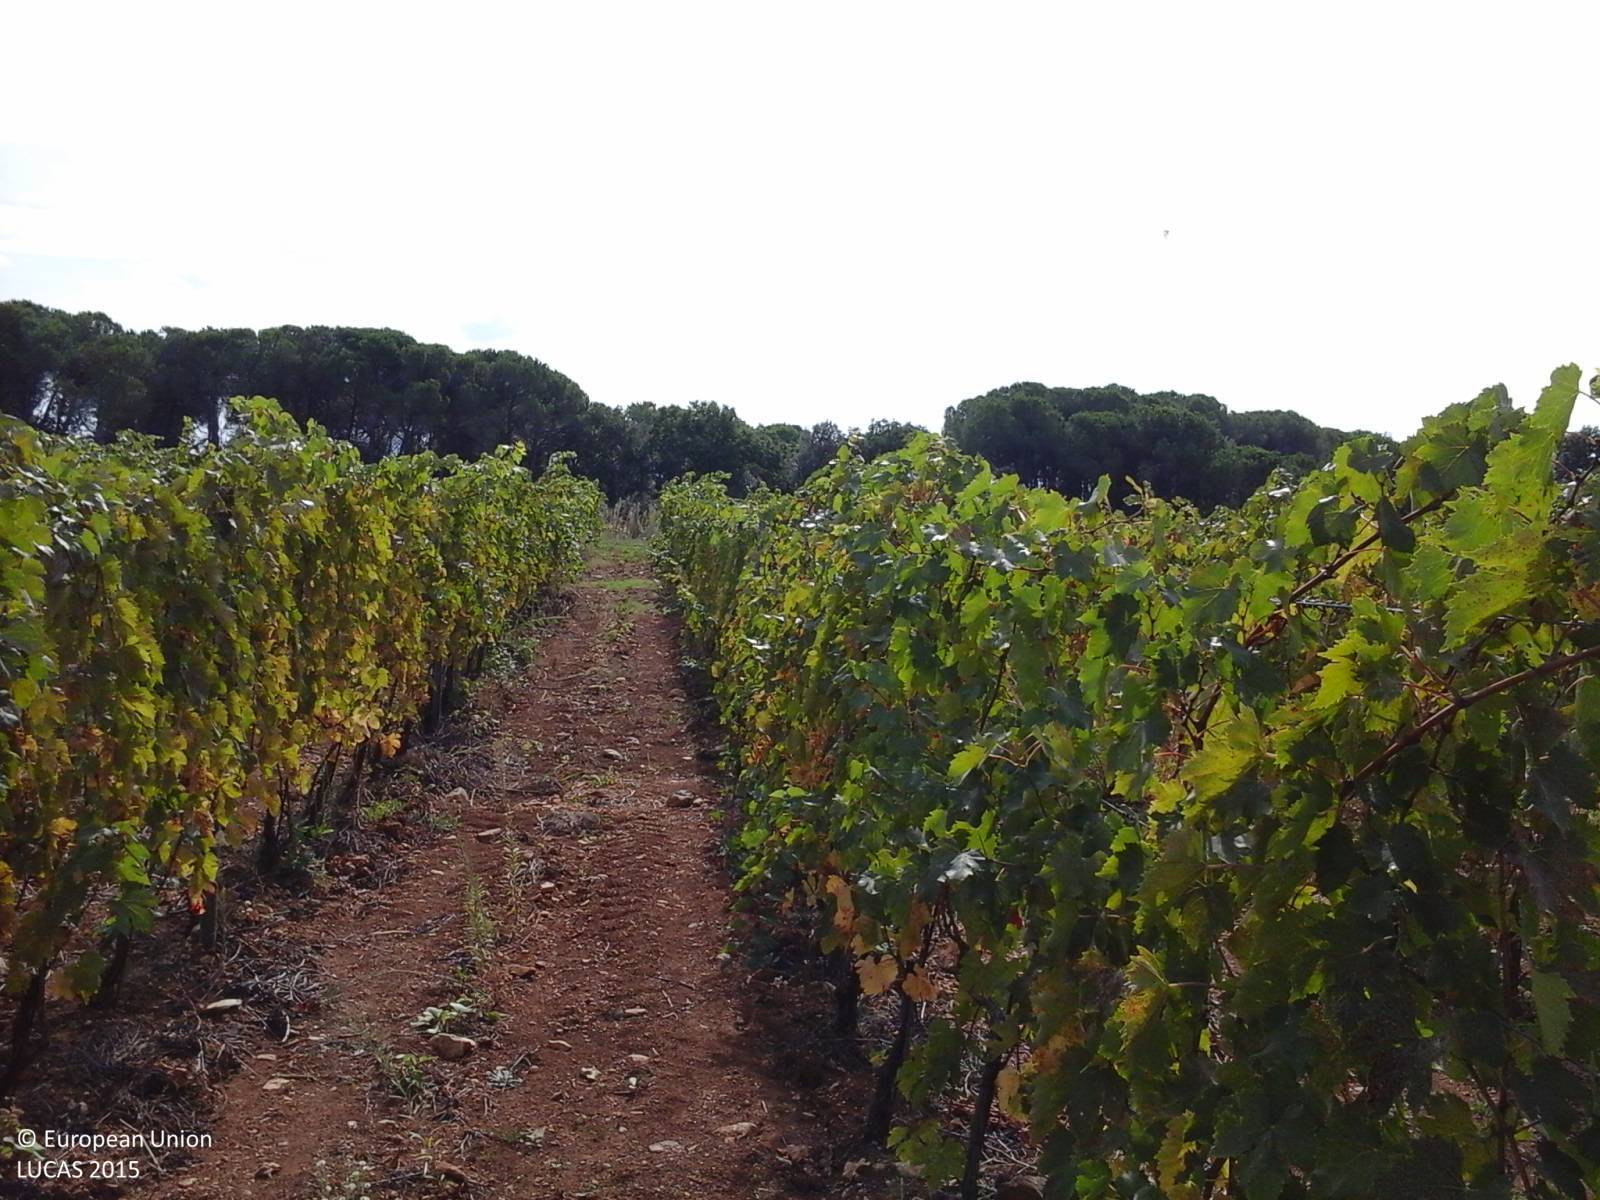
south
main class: Cropland
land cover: Vineyards
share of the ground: 50 - 75 %
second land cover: Other bare soil
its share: > 75 %
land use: Agriculture (excluding fallow land and kitchen gardens)
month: October
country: IT
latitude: 43.2481
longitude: 10.6017
